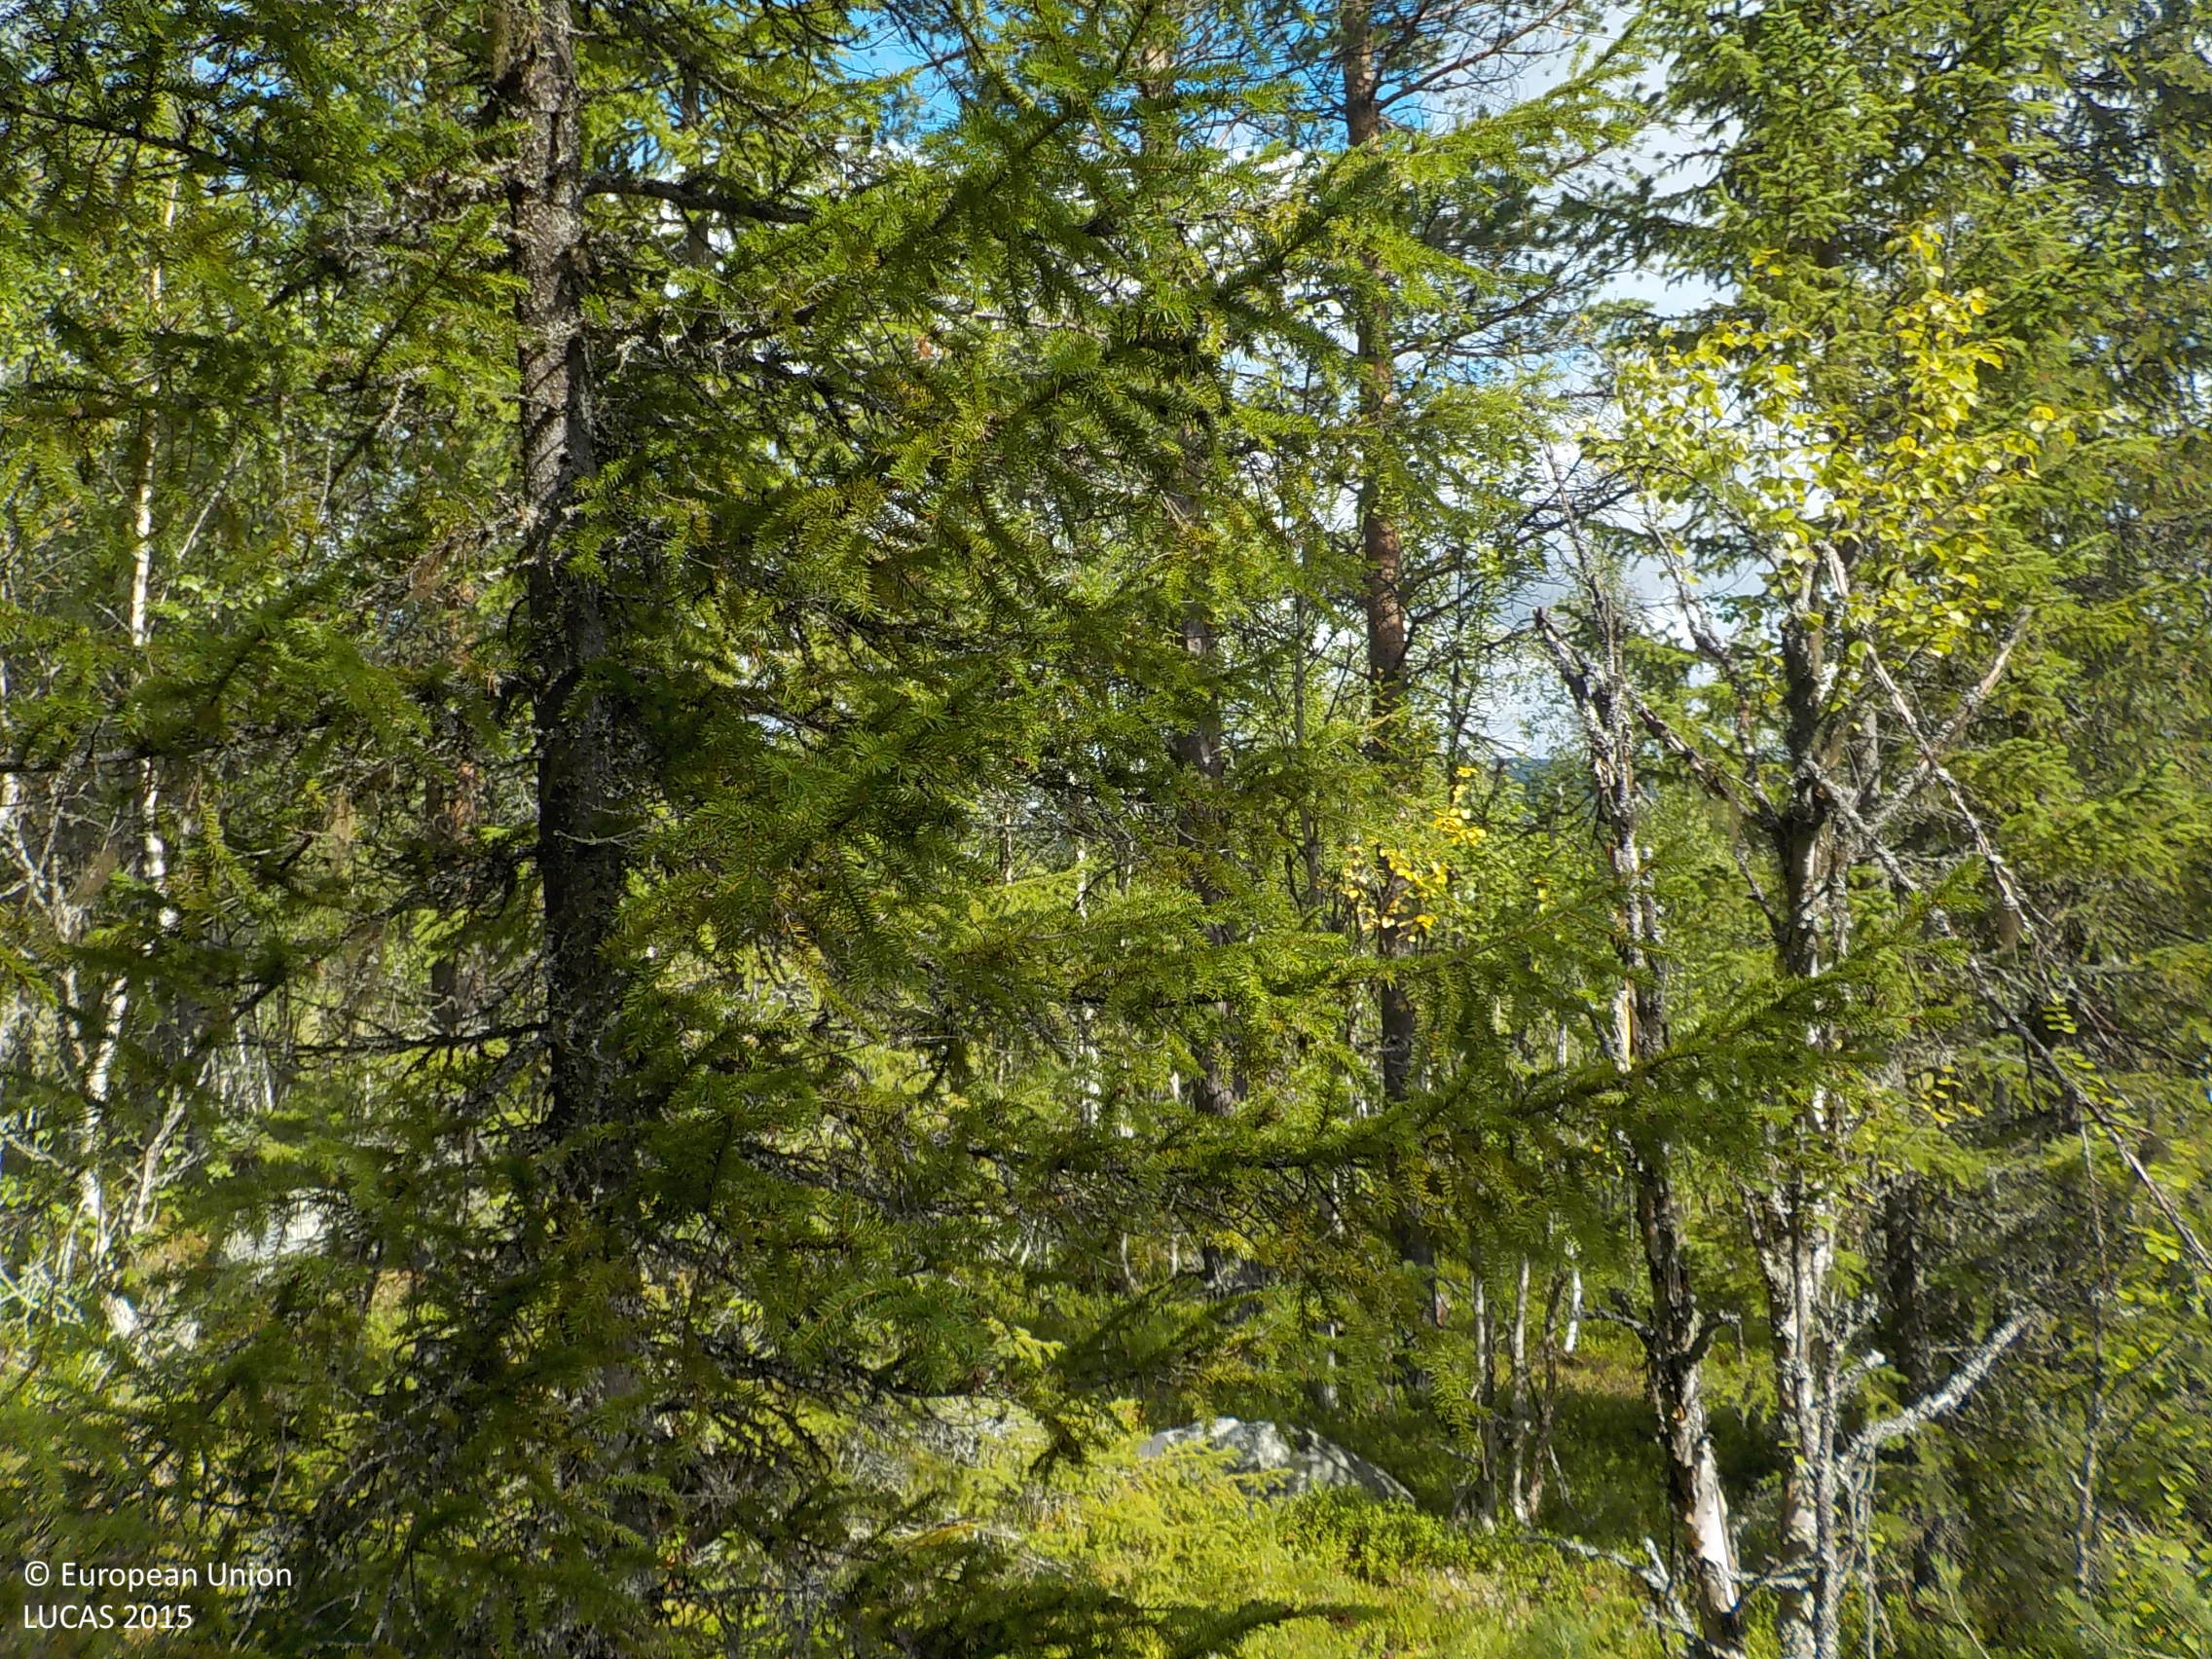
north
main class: Woodland
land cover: Pine dominated mixed woodland
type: boreal forest
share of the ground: > 75 %
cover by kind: coniferous forest trees 50 %, broadleaved forest trees 30 %, shrubs 20 %
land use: Forestry
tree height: > 5 m
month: August
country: SE
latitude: 64.0680
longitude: 17.6562
